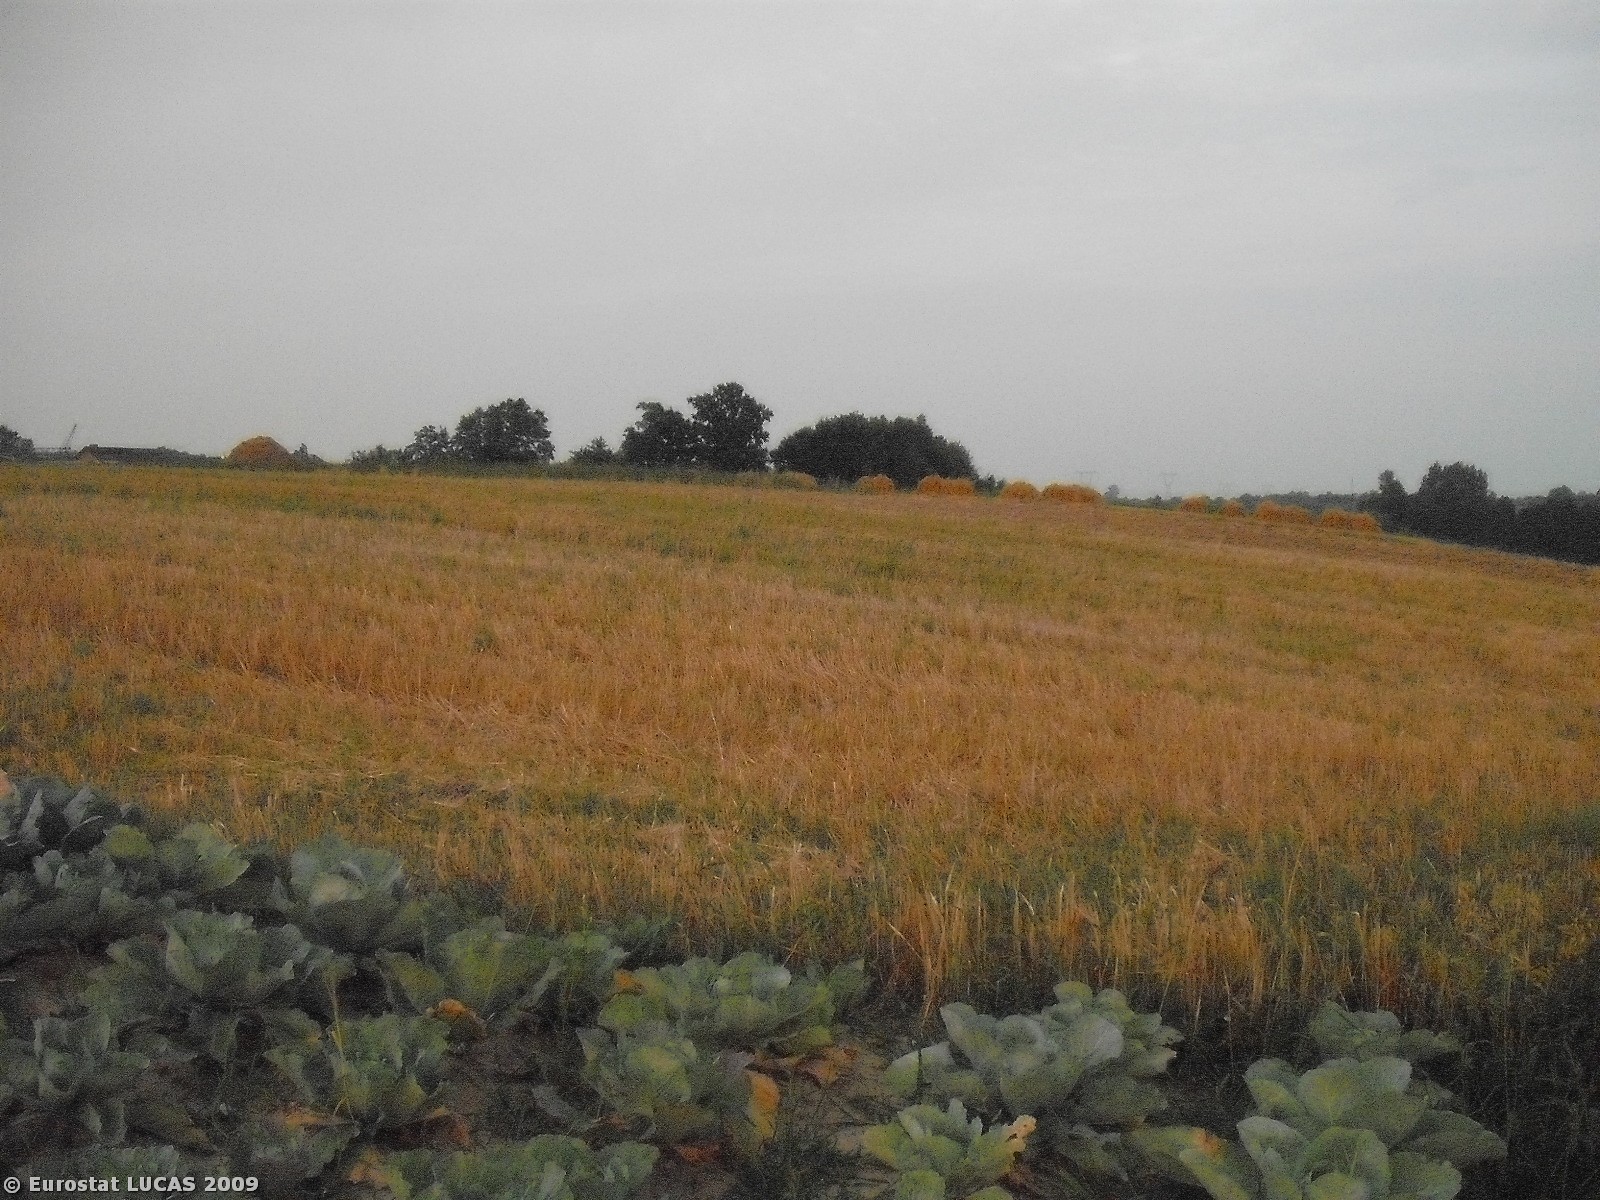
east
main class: Cropland
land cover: Other fresh vegetables
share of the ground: 50 - 75 %
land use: Kitchen garden
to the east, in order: Other fresh vegetables; Oats; Bare land; Grass margins; Bare land; Potatoes; Oats; Strawberries; Grass margins; Potatoes; Grassland without tree/shrub cover; Tracks; Grassland without tree/shrub cover
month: August
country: PL
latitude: 50.5576
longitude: 20.8119
